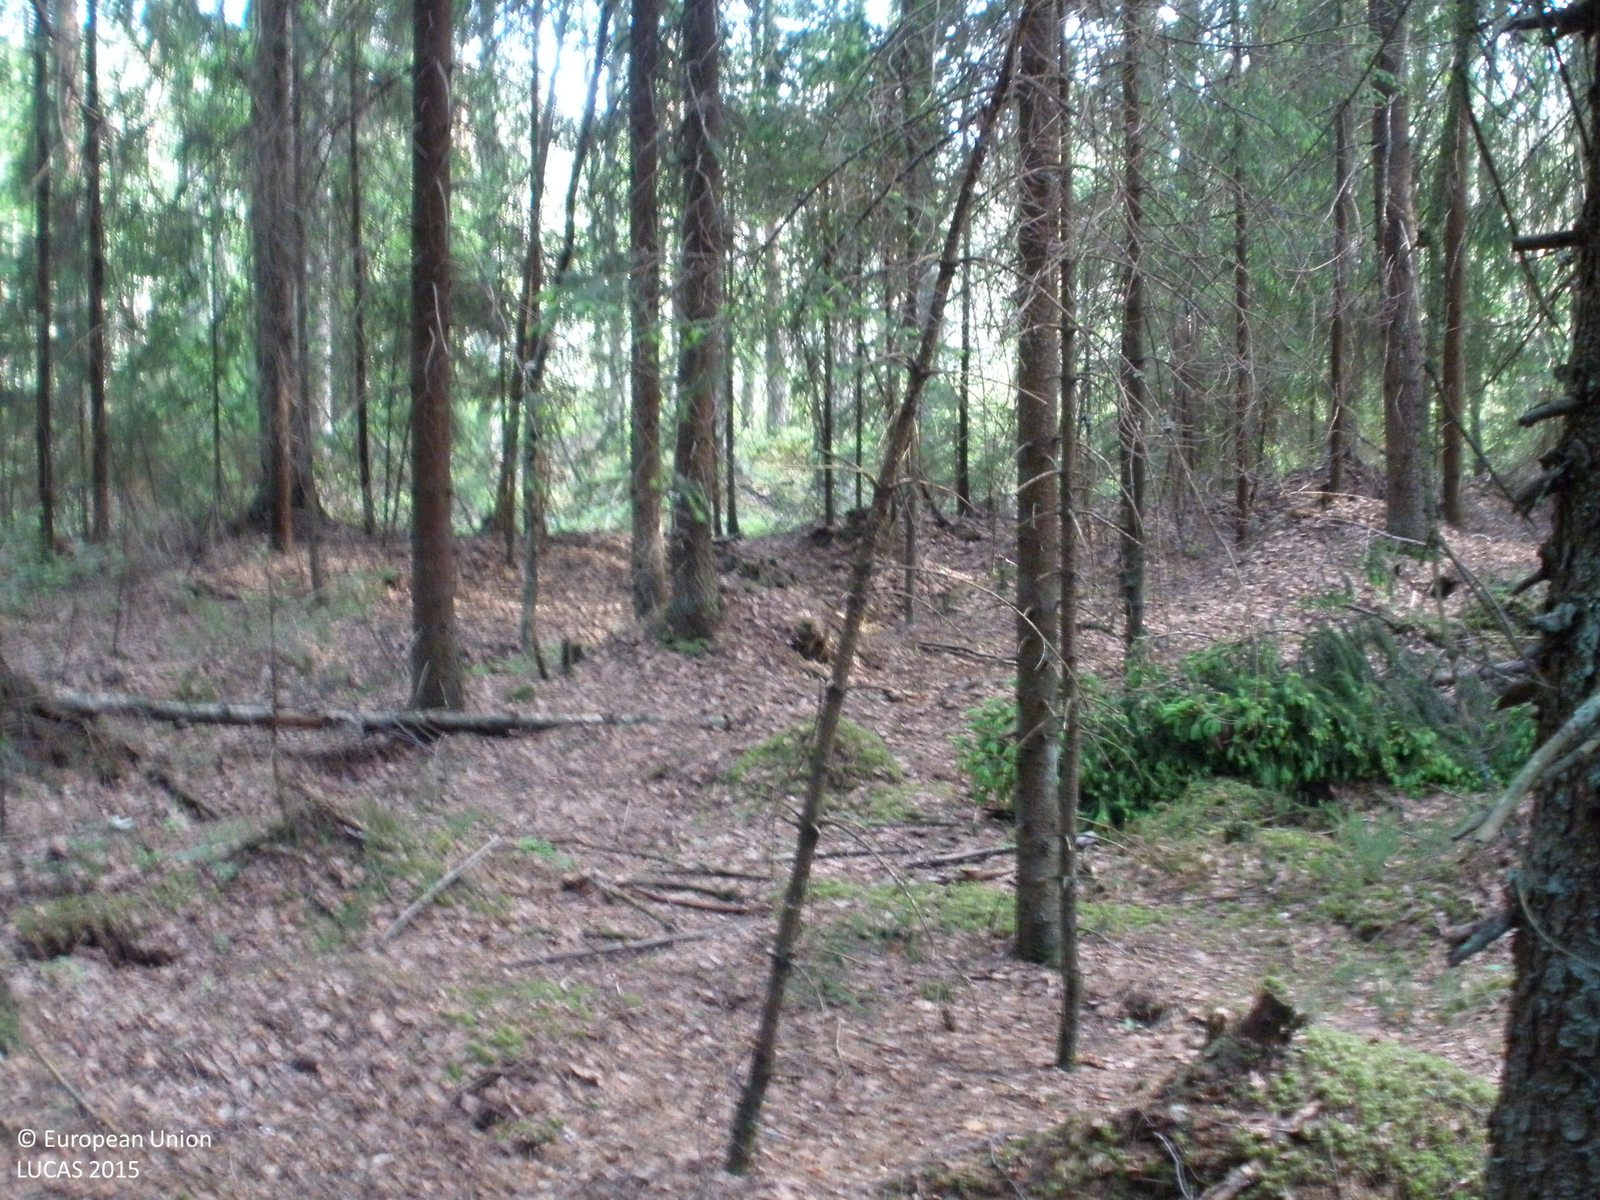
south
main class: Woodland
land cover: Spruce dominated coniferous woodland
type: boreal forest
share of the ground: > 75 %
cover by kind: coniferous forest trees 90 %, broadleaved forest trees 5 %, lichens and mosses 5 %
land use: Forestry
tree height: > 5 m
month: June
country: FI
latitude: 61.3006
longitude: 23.9212
